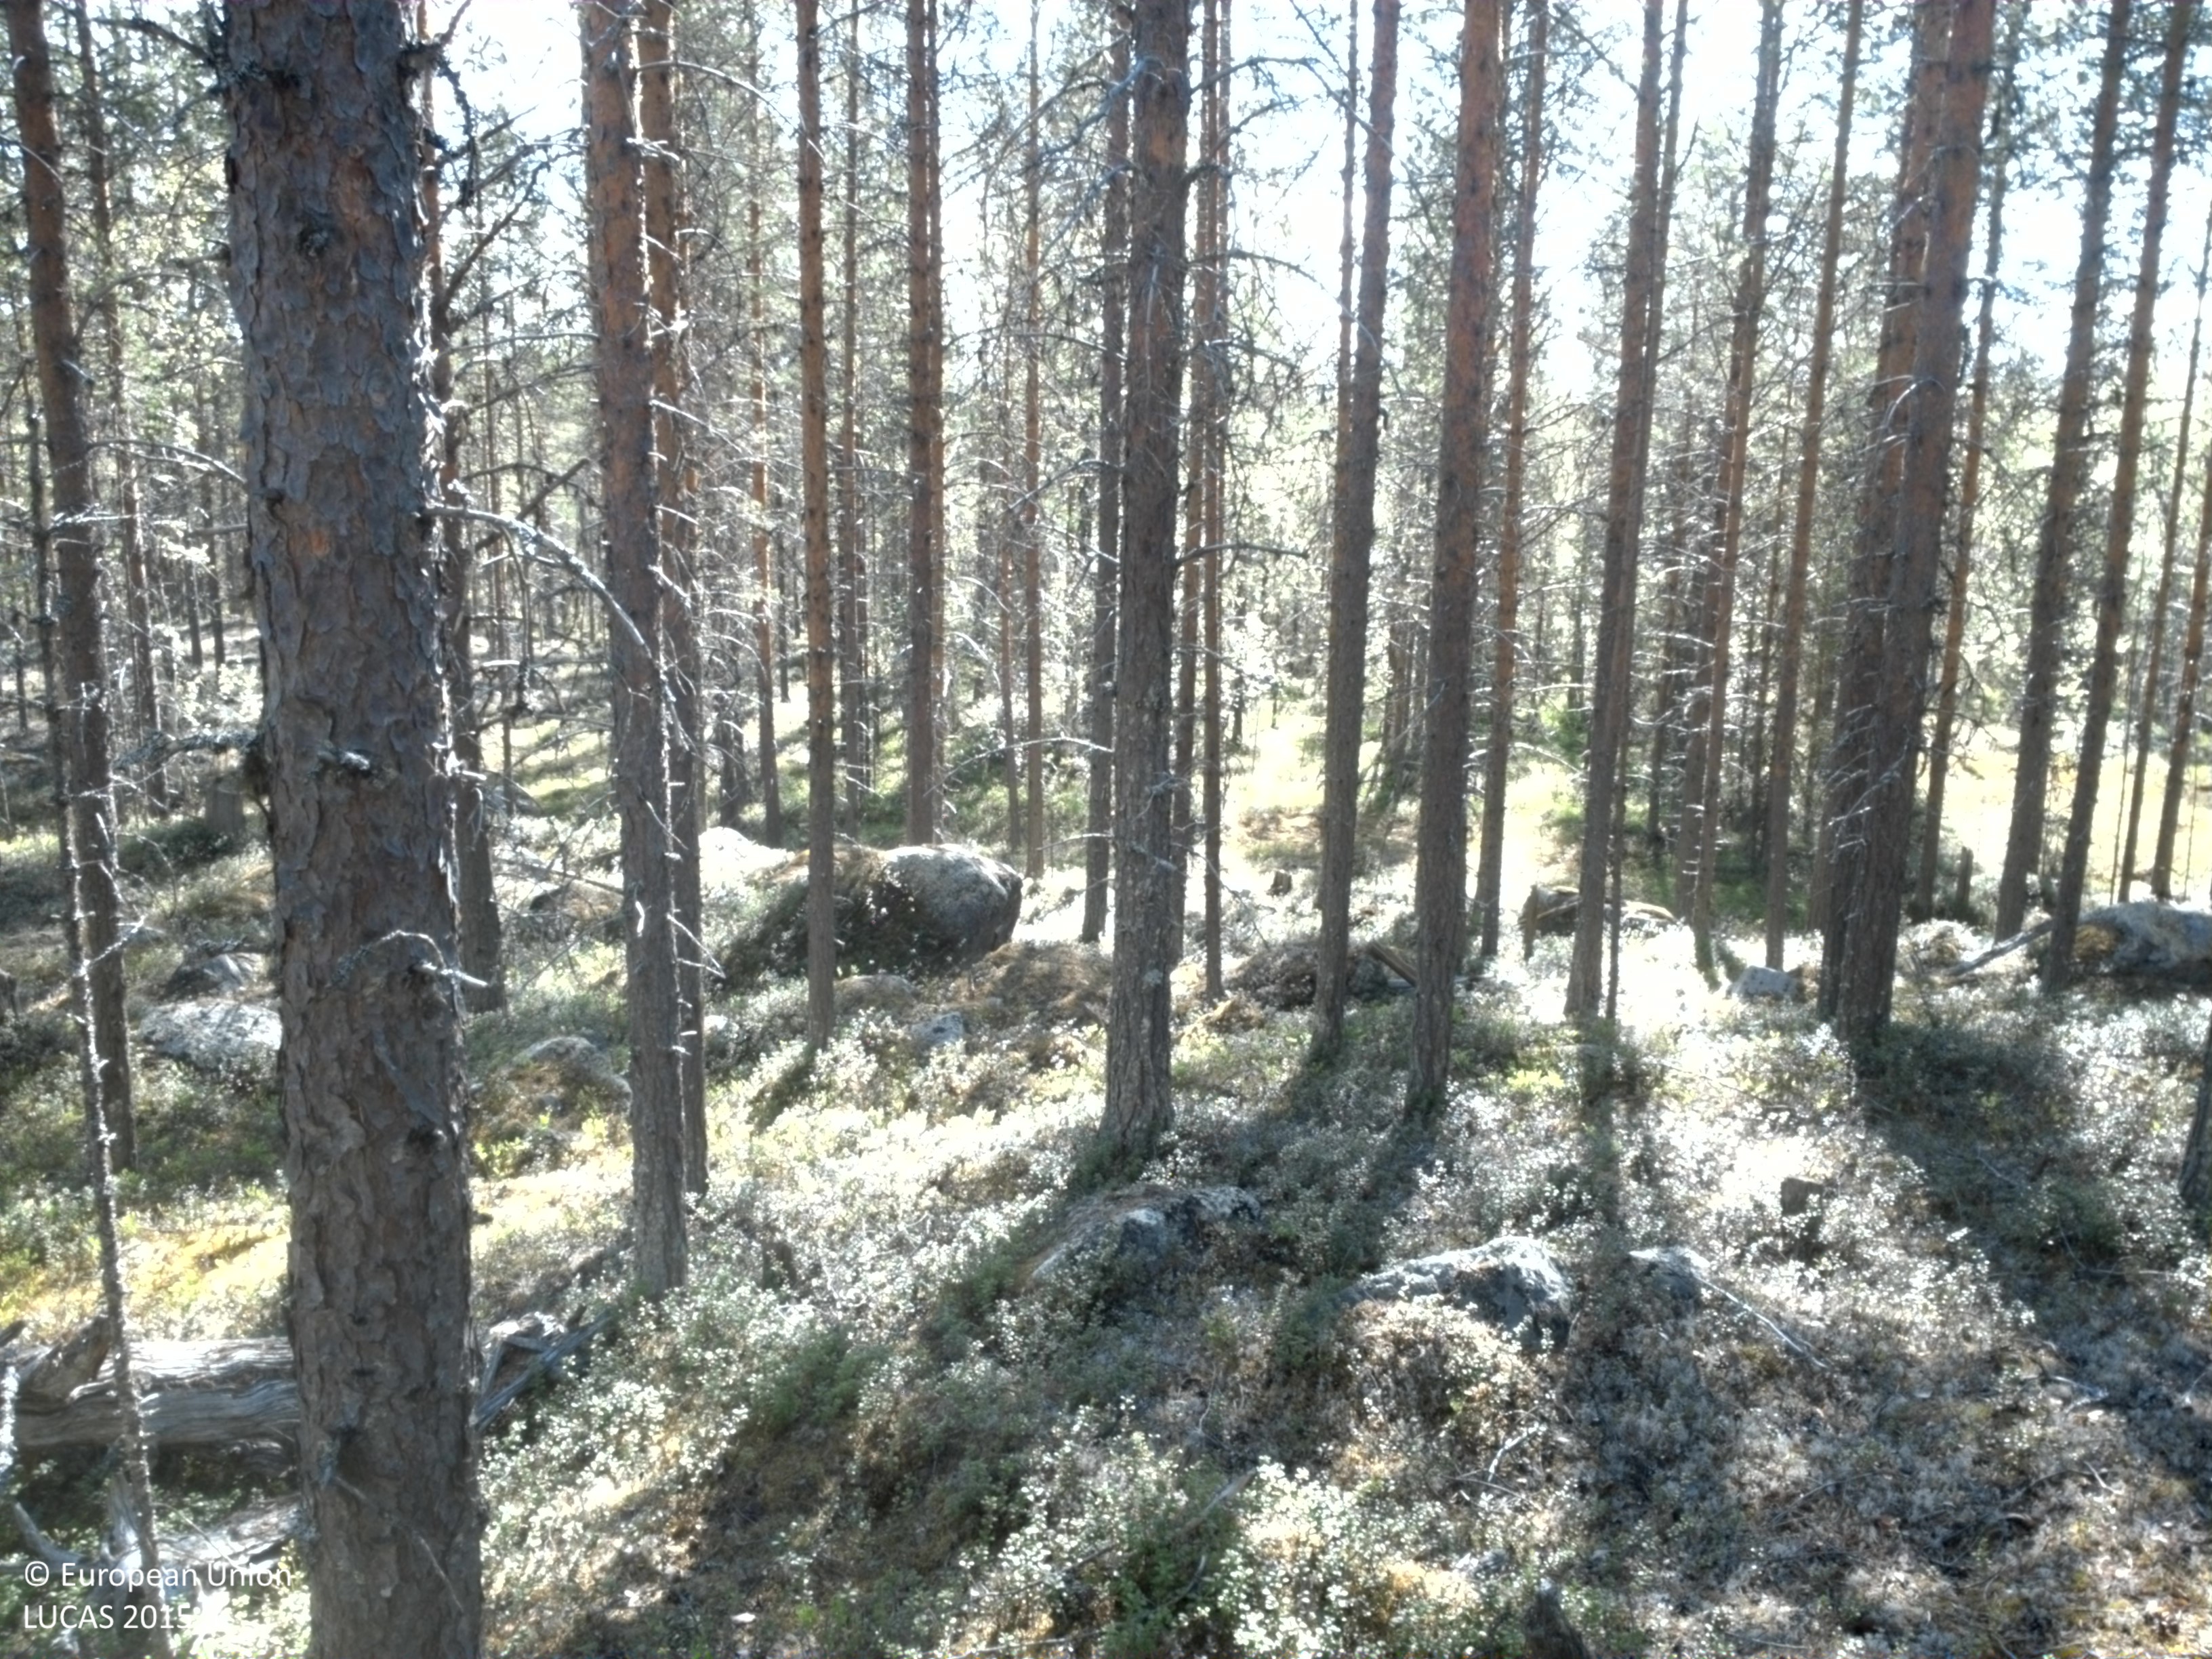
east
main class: Woodland
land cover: Pine dominated coniferous woodland
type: boreal forest
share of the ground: 25 - 50 %
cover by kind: shrubs 45 %, coniferous forest trees 40 %, consolidated bare surface 10 %, lichens and mosses 5 %
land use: Forestry
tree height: > 5 m
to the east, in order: Pine dominated coniferous woodland; Shrubland with sparse tree cover; Pine dominated coniferous woodland; Tracks; Pine dominated coniferous woodland
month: June
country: SE
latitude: 66.0492
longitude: 19.4274
